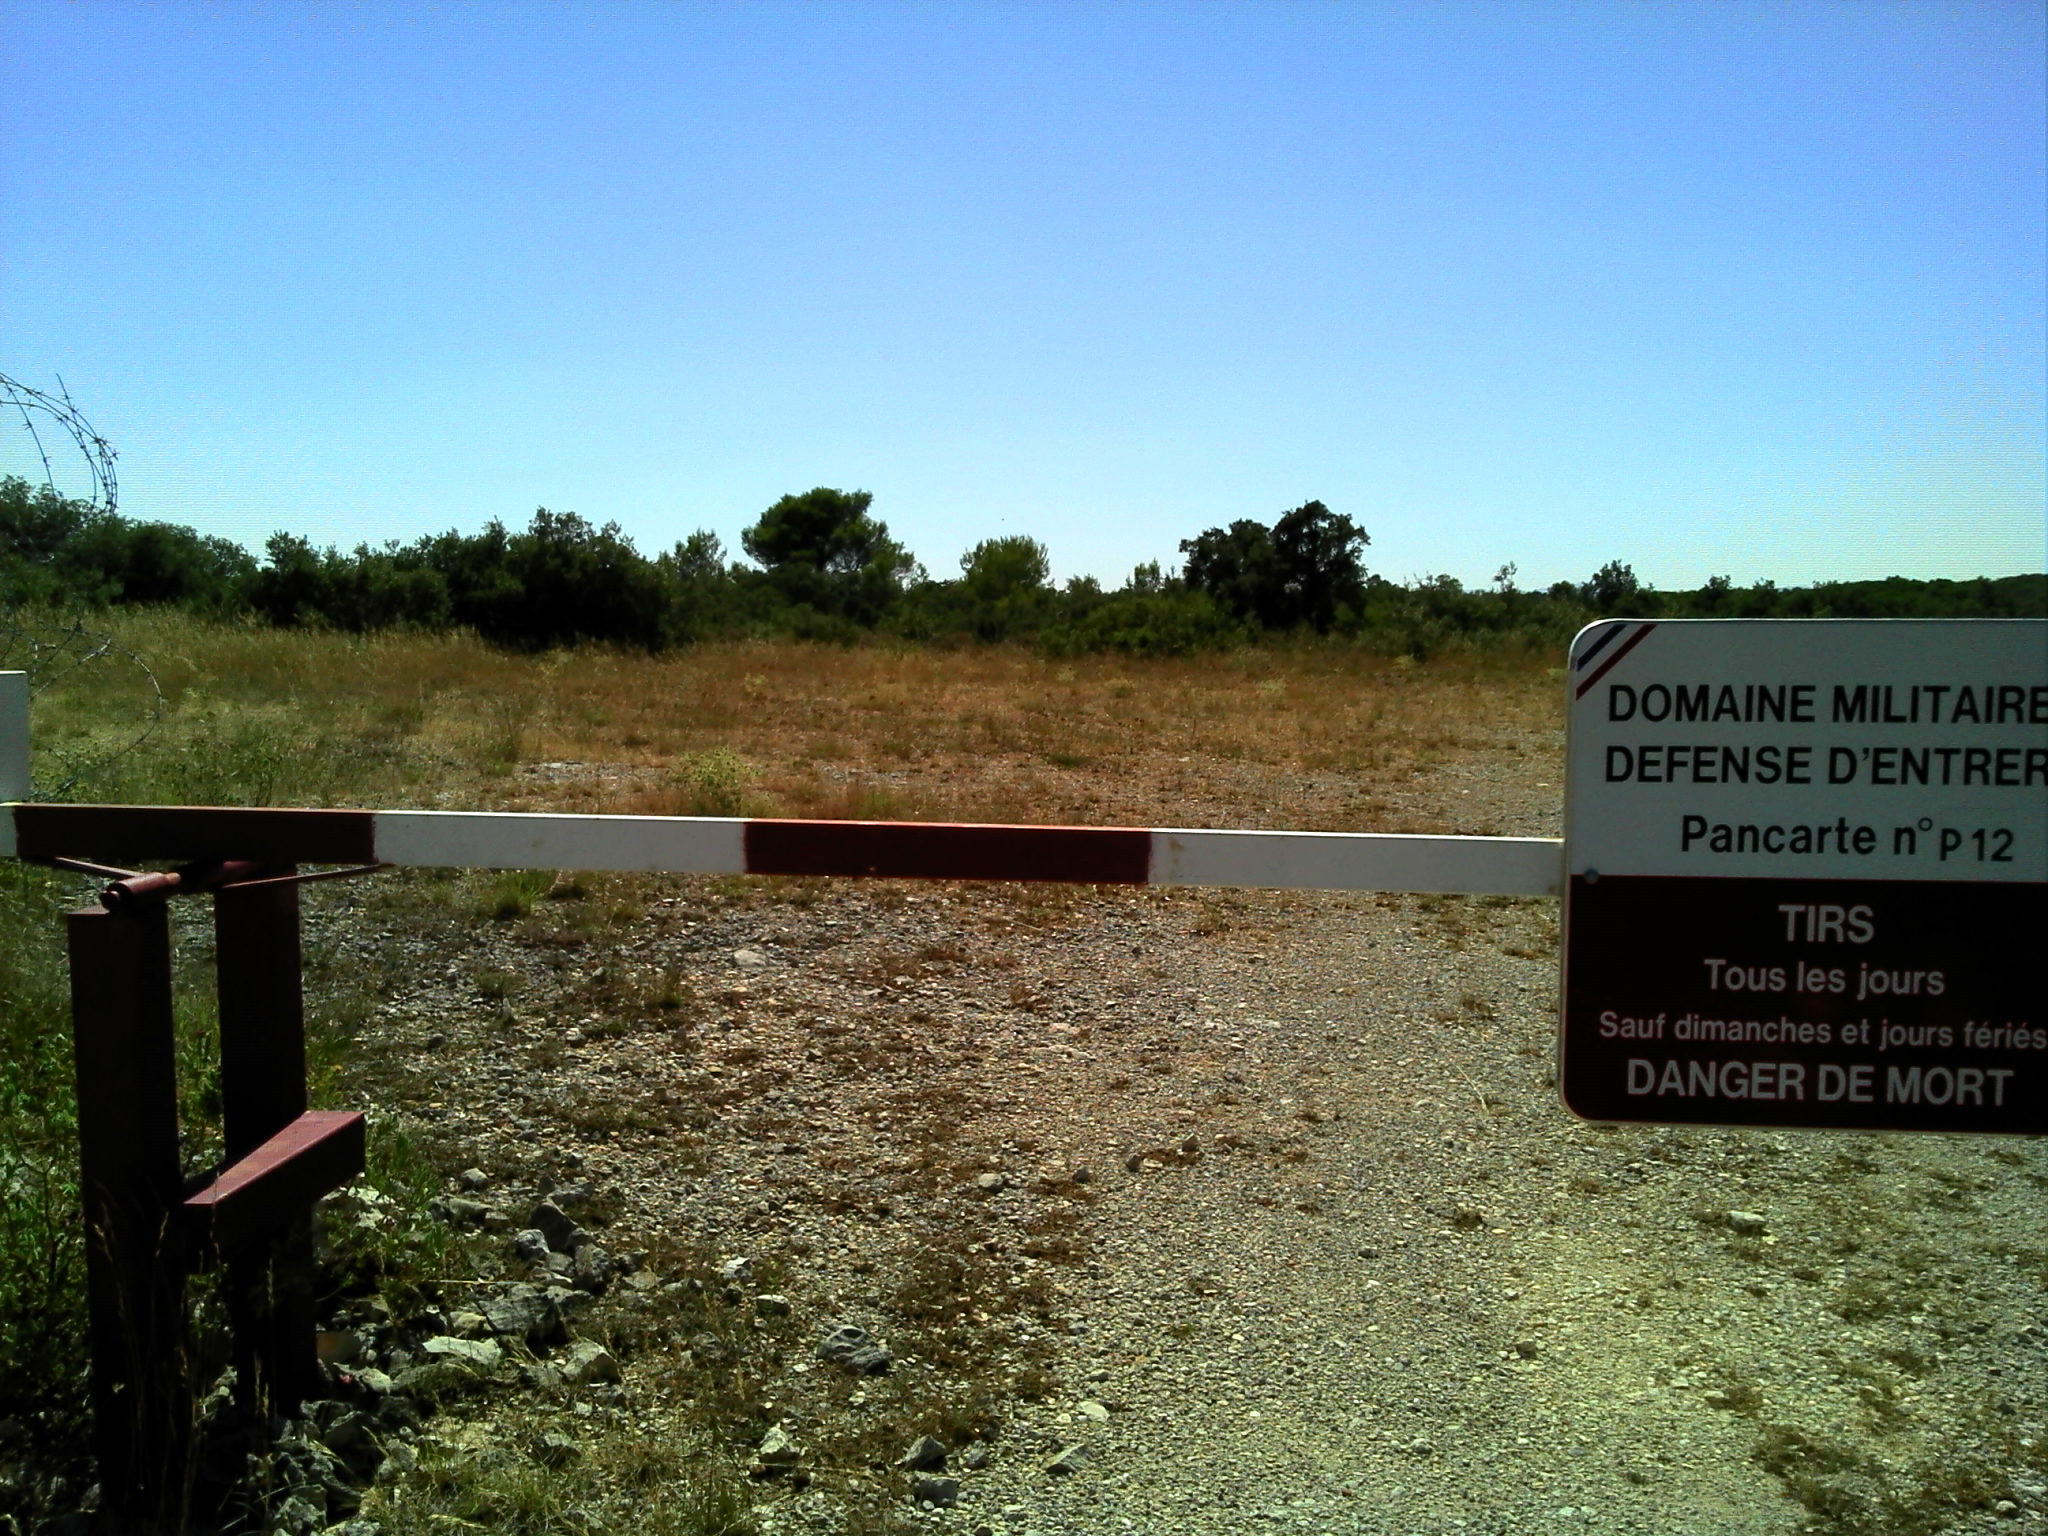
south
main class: Shrubland
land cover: Shrubland with sparse tree cover
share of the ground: 50 - 75 %
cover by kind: shrubs 50 %, herbaceous plants 45 %, broadleaved forest trees 5 %
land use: Community services
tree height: > 5 m
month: July
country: FR
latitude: 43.8876
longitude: 4.3201
